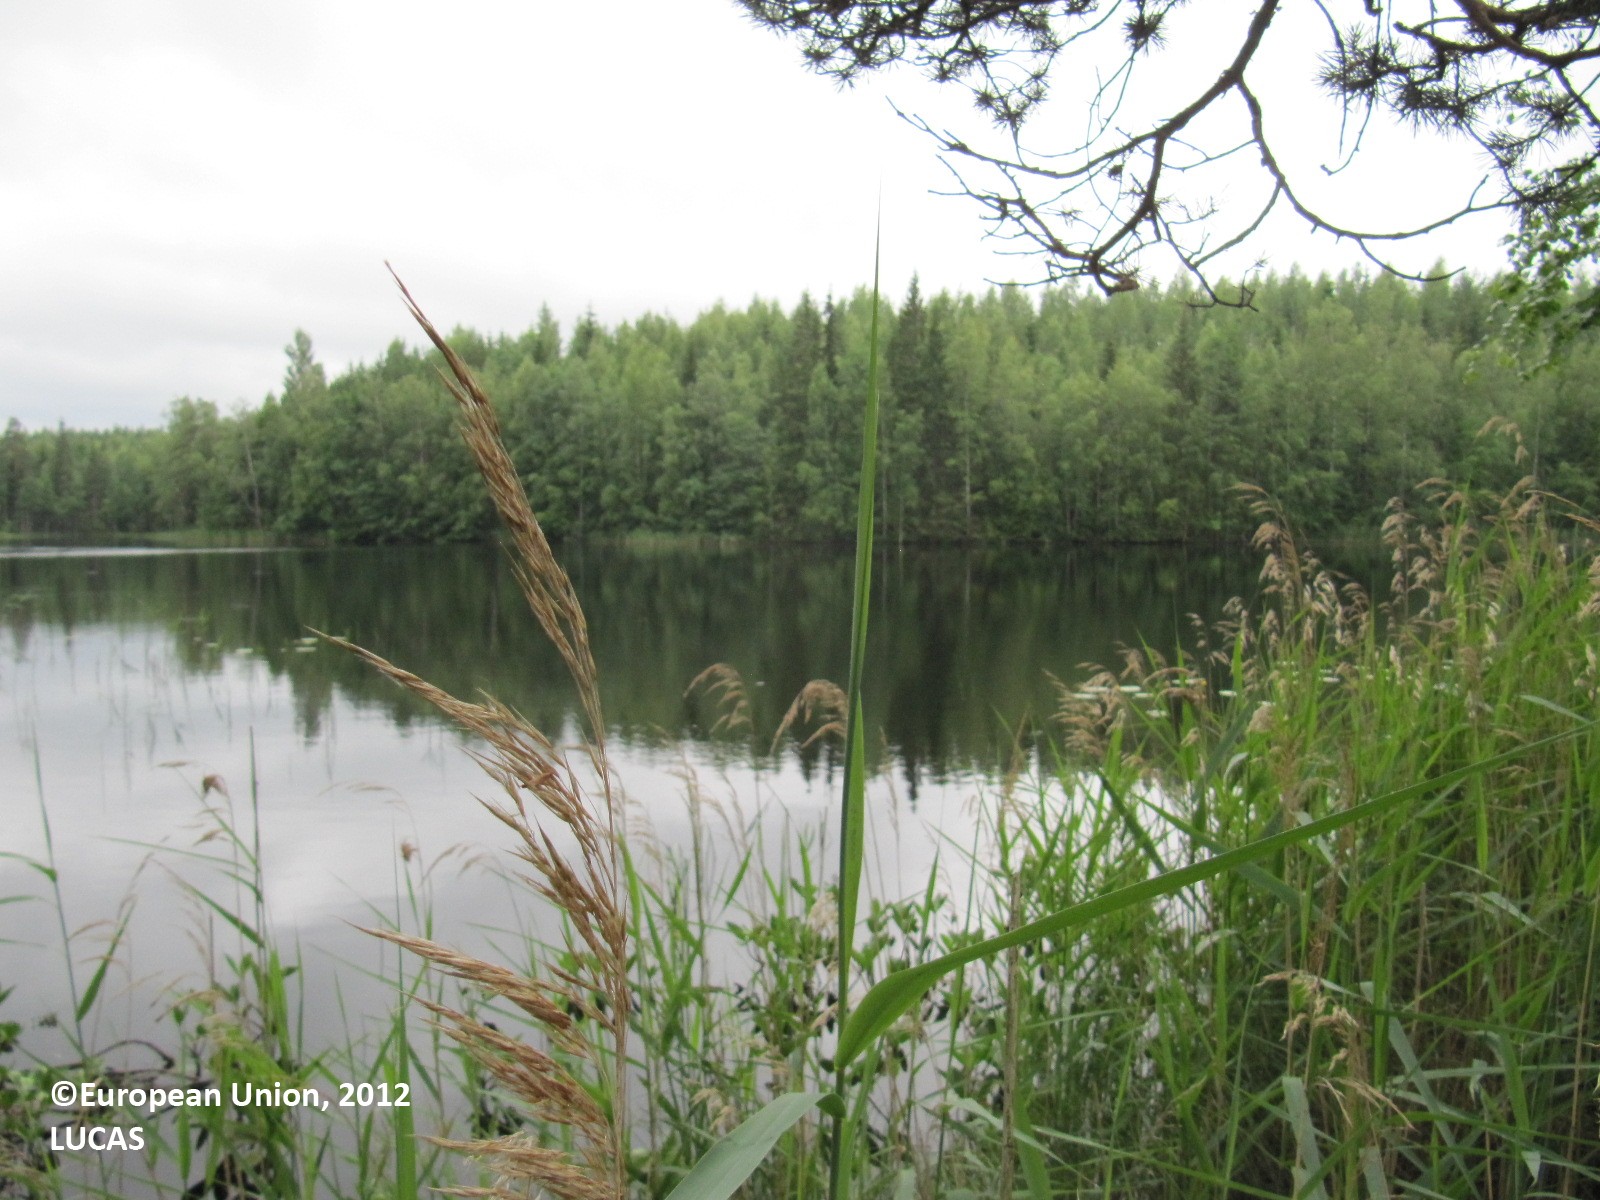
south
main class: Woodland
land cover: Other mixed woodland
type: boreal forest
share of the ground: > 75 %
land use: Forestry
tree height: > 5 m
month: July
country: FI
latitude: 60.9273
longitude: 24.1727
